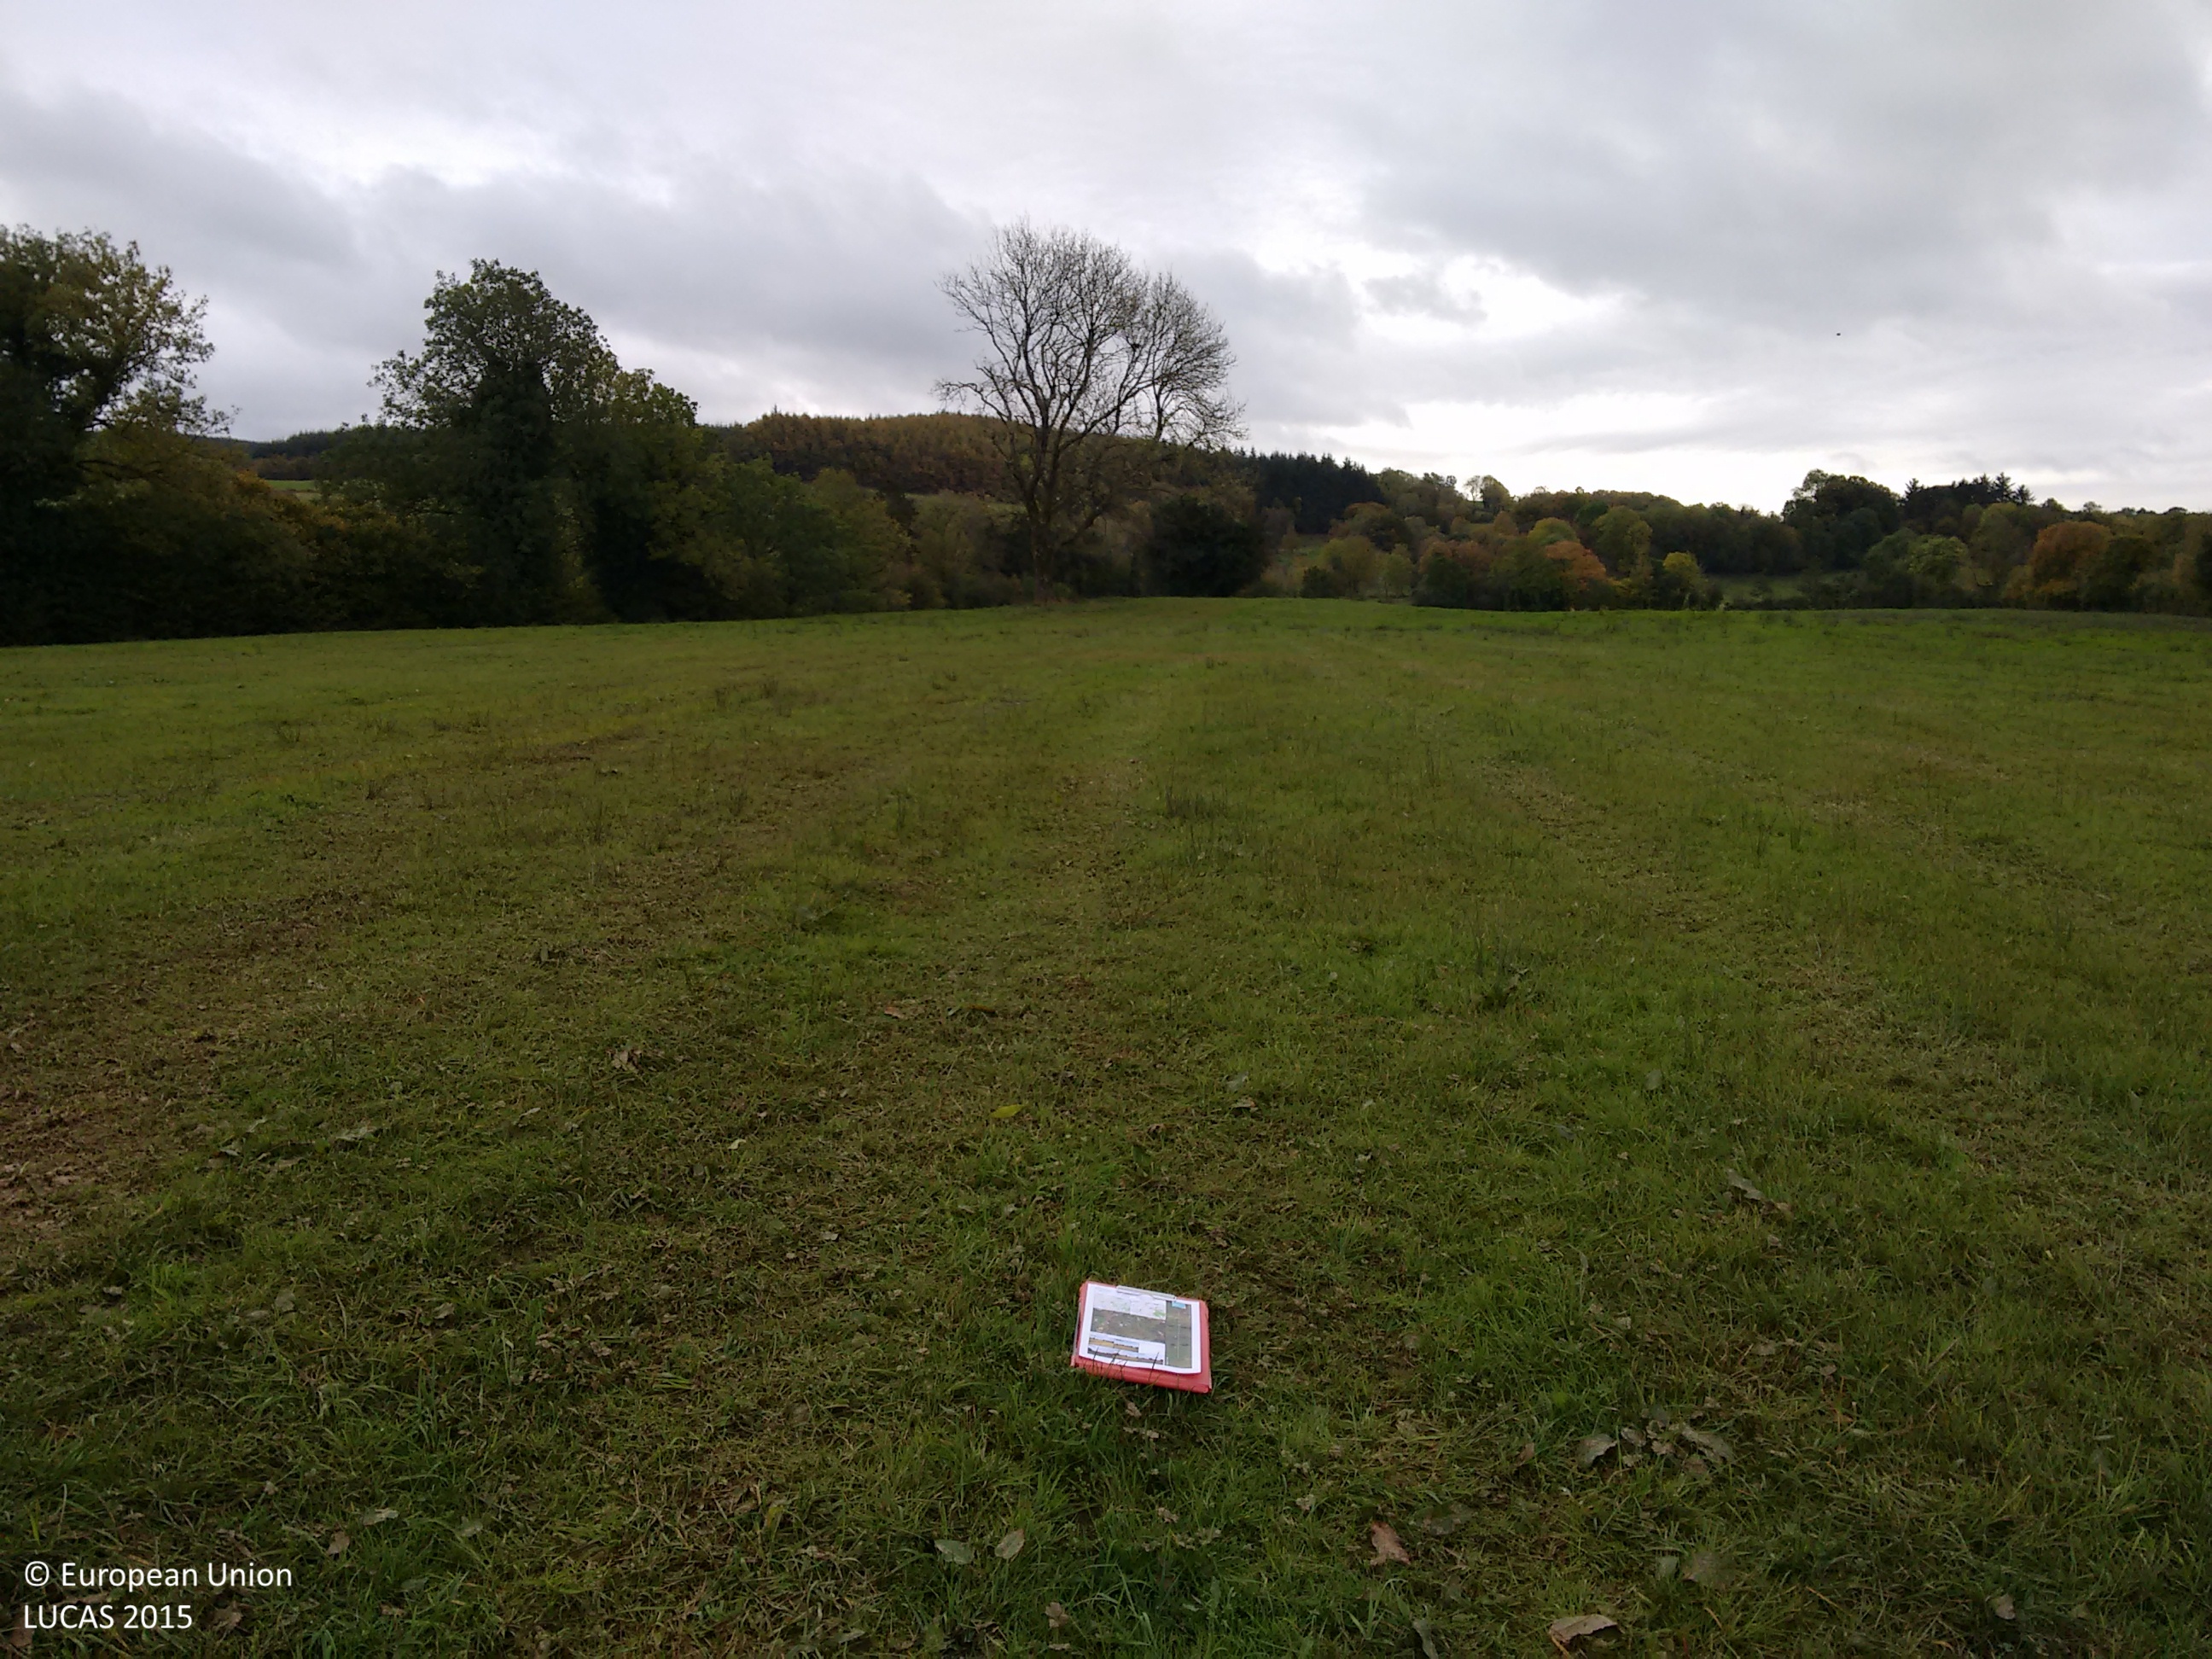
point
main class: Grassland
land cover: Grassland without tree/shrub cover
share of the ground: > 75 %
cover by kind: herbaceous plants 100 %
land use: Agriculture (excluding fallow land and kitchen gardens)
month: October
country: GB
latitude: 54.3008
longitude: -7.4101
